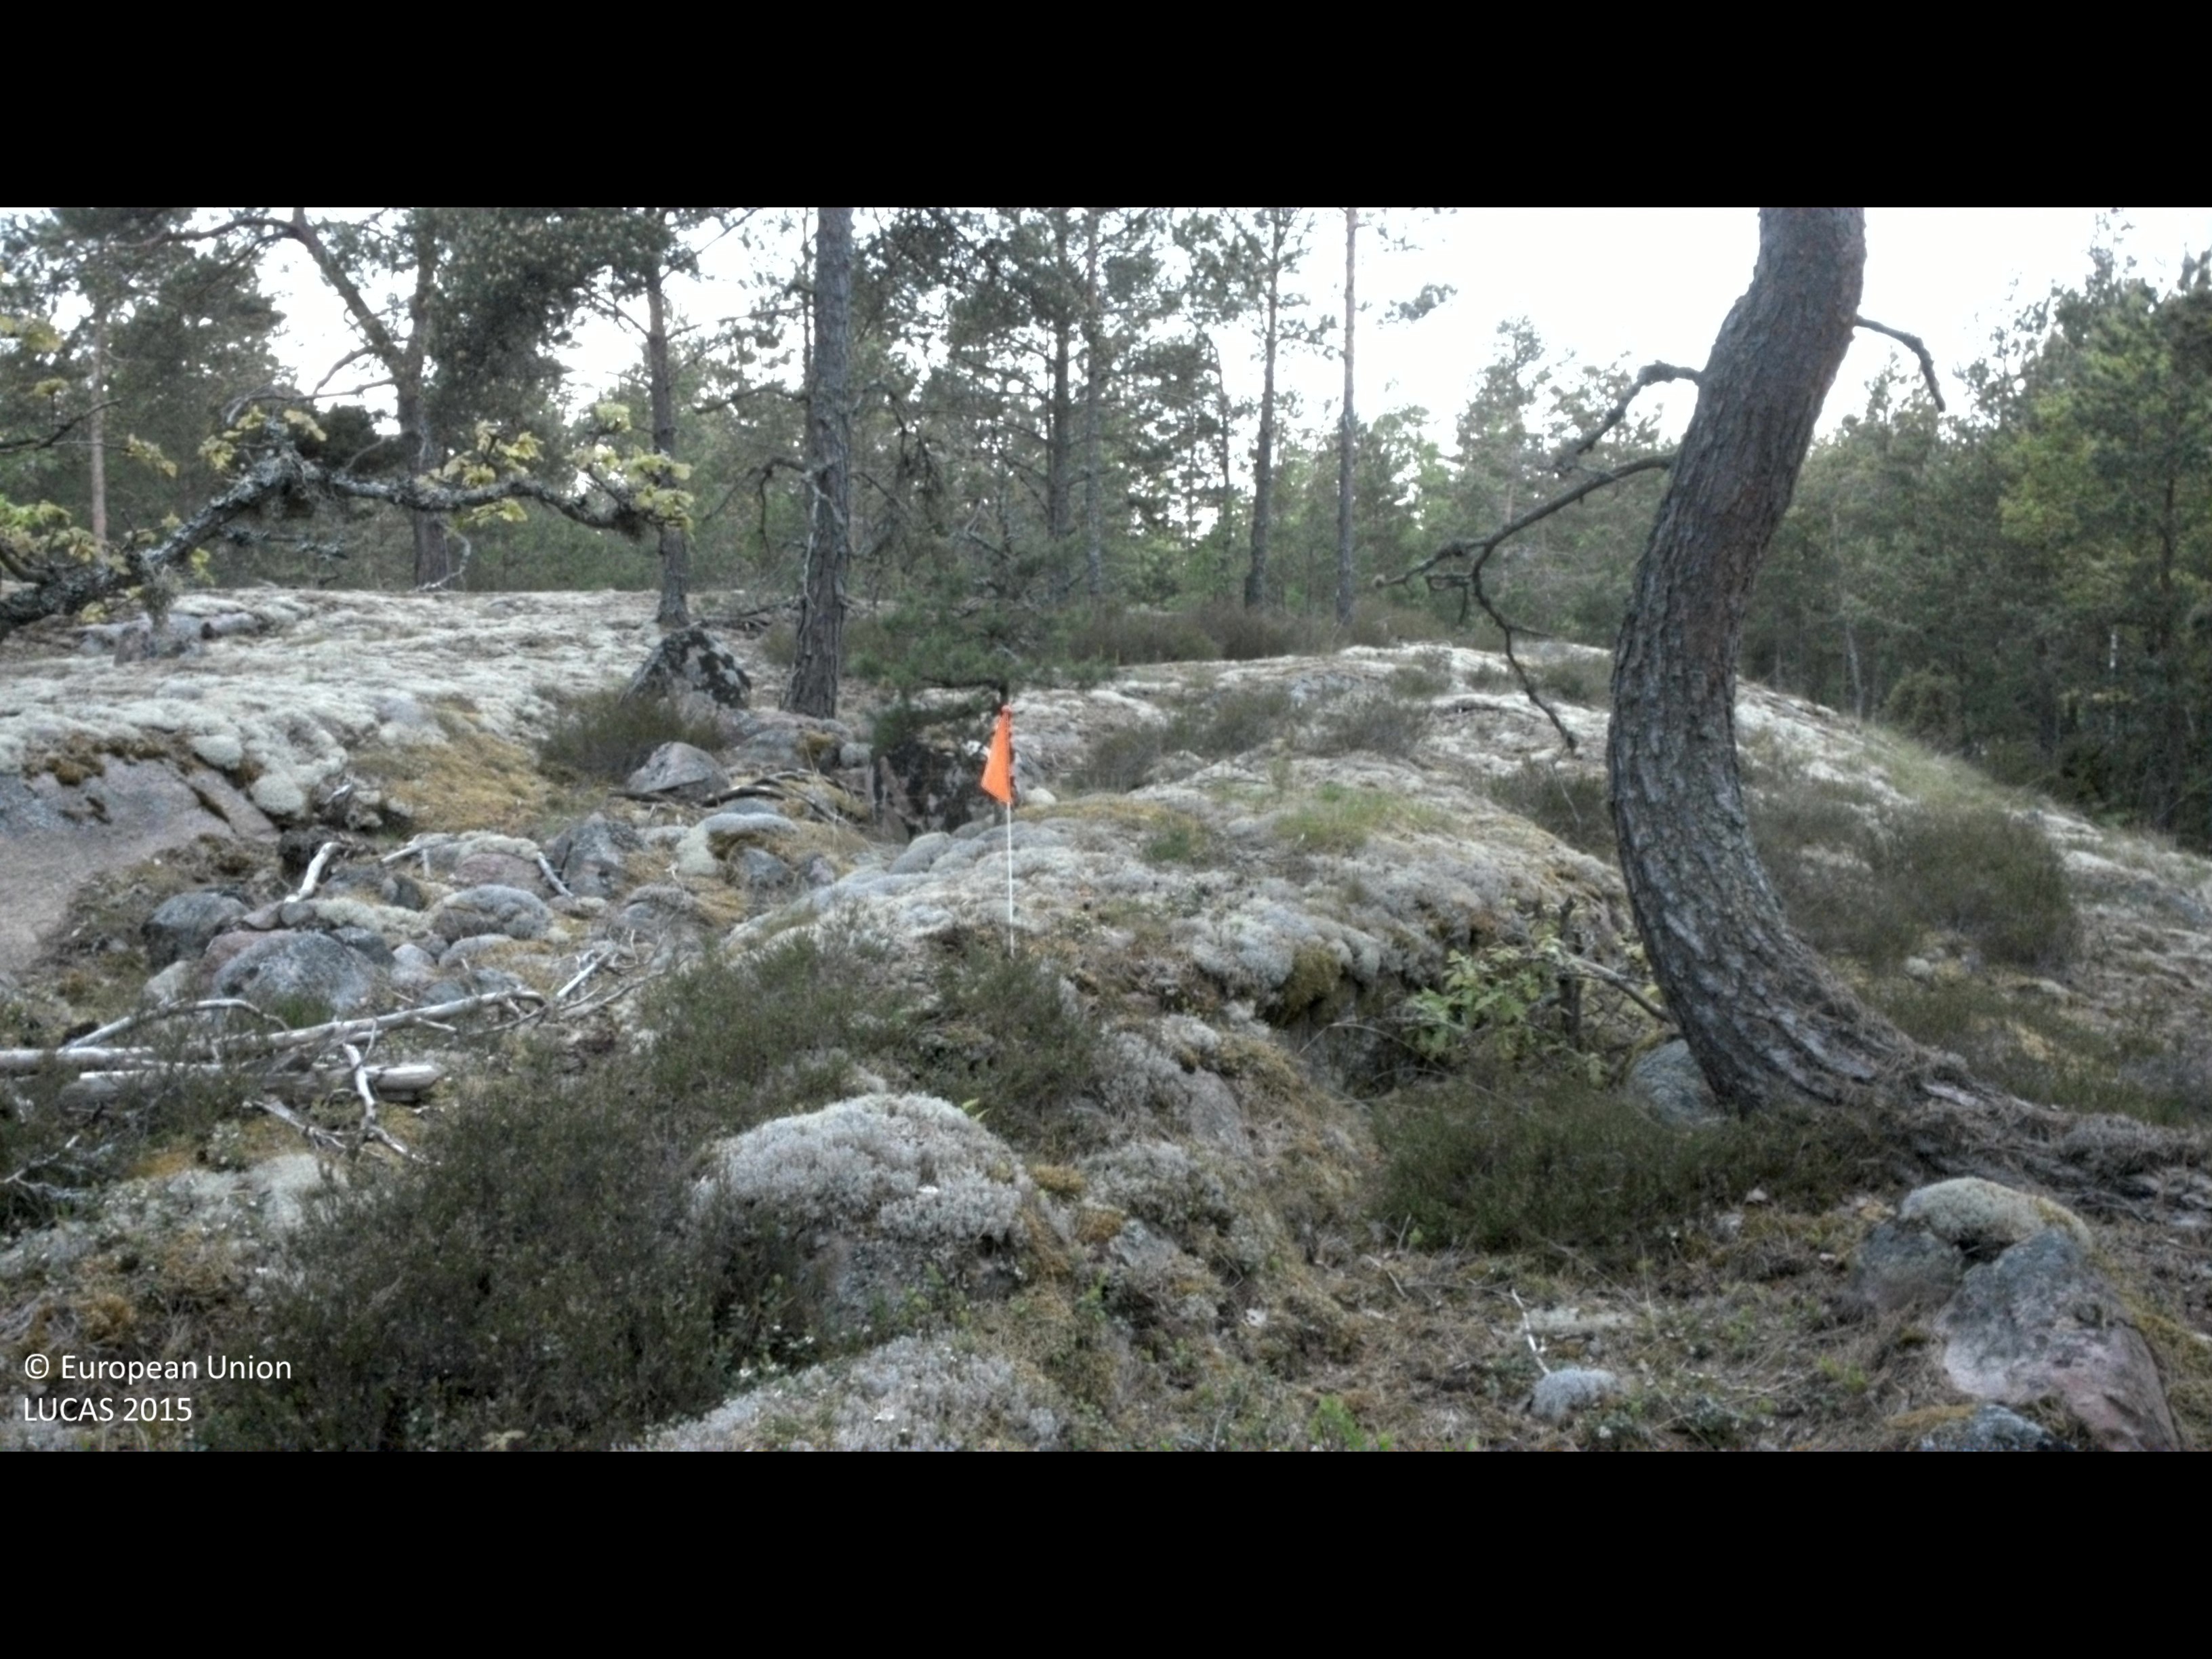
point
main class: Woodland
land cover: Pine dominated coniferous woodland
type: boreal forest
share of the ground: 50 - 75 %
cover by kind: coniferous forest trees 60 %, shrubs 20 %, lichens and mosses 15 %, broadleaved forest trees 5 %
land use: Forestry
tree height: > 5 m
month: May
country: SE
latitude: 57.4770
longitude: 16.6537
